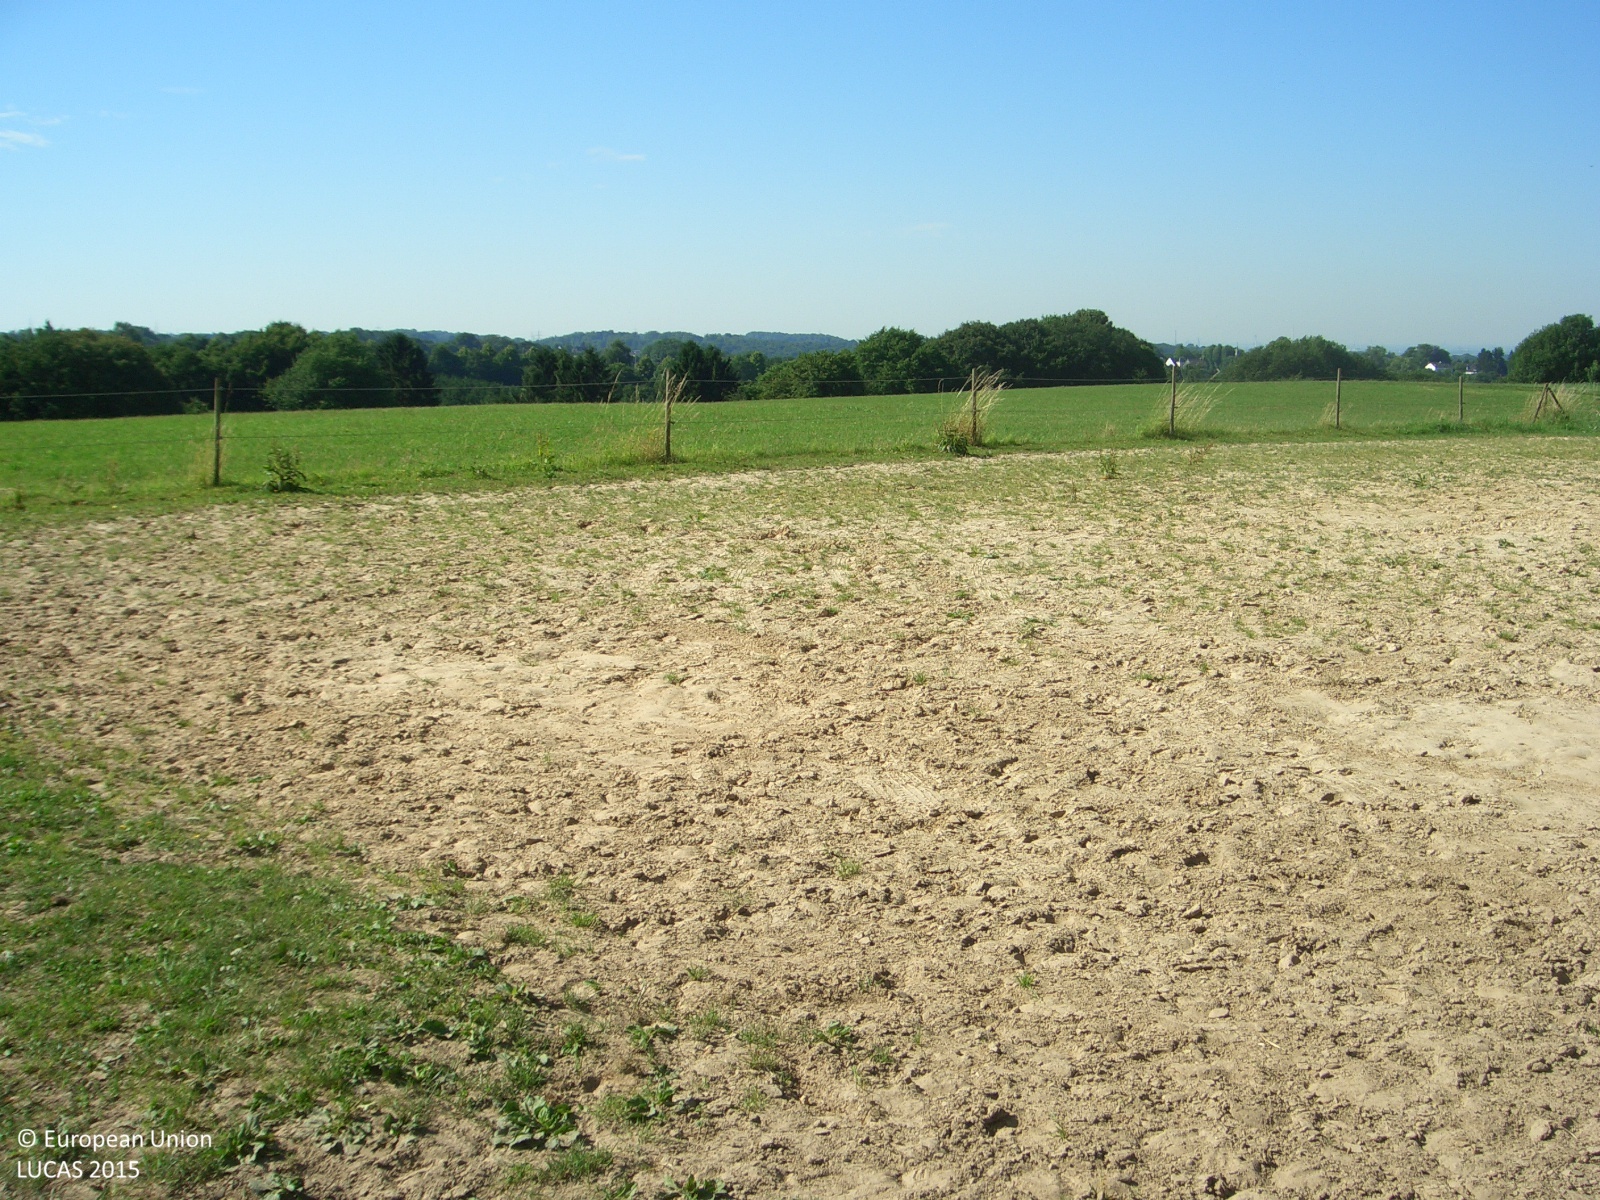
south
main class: Woodland
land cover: Pine dominated coniferous woodland
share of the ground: > 75 %
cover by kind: coniferous forest trees 100 %
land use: Residential
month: July
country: DE
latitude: 51.1534
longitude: 7.0405
